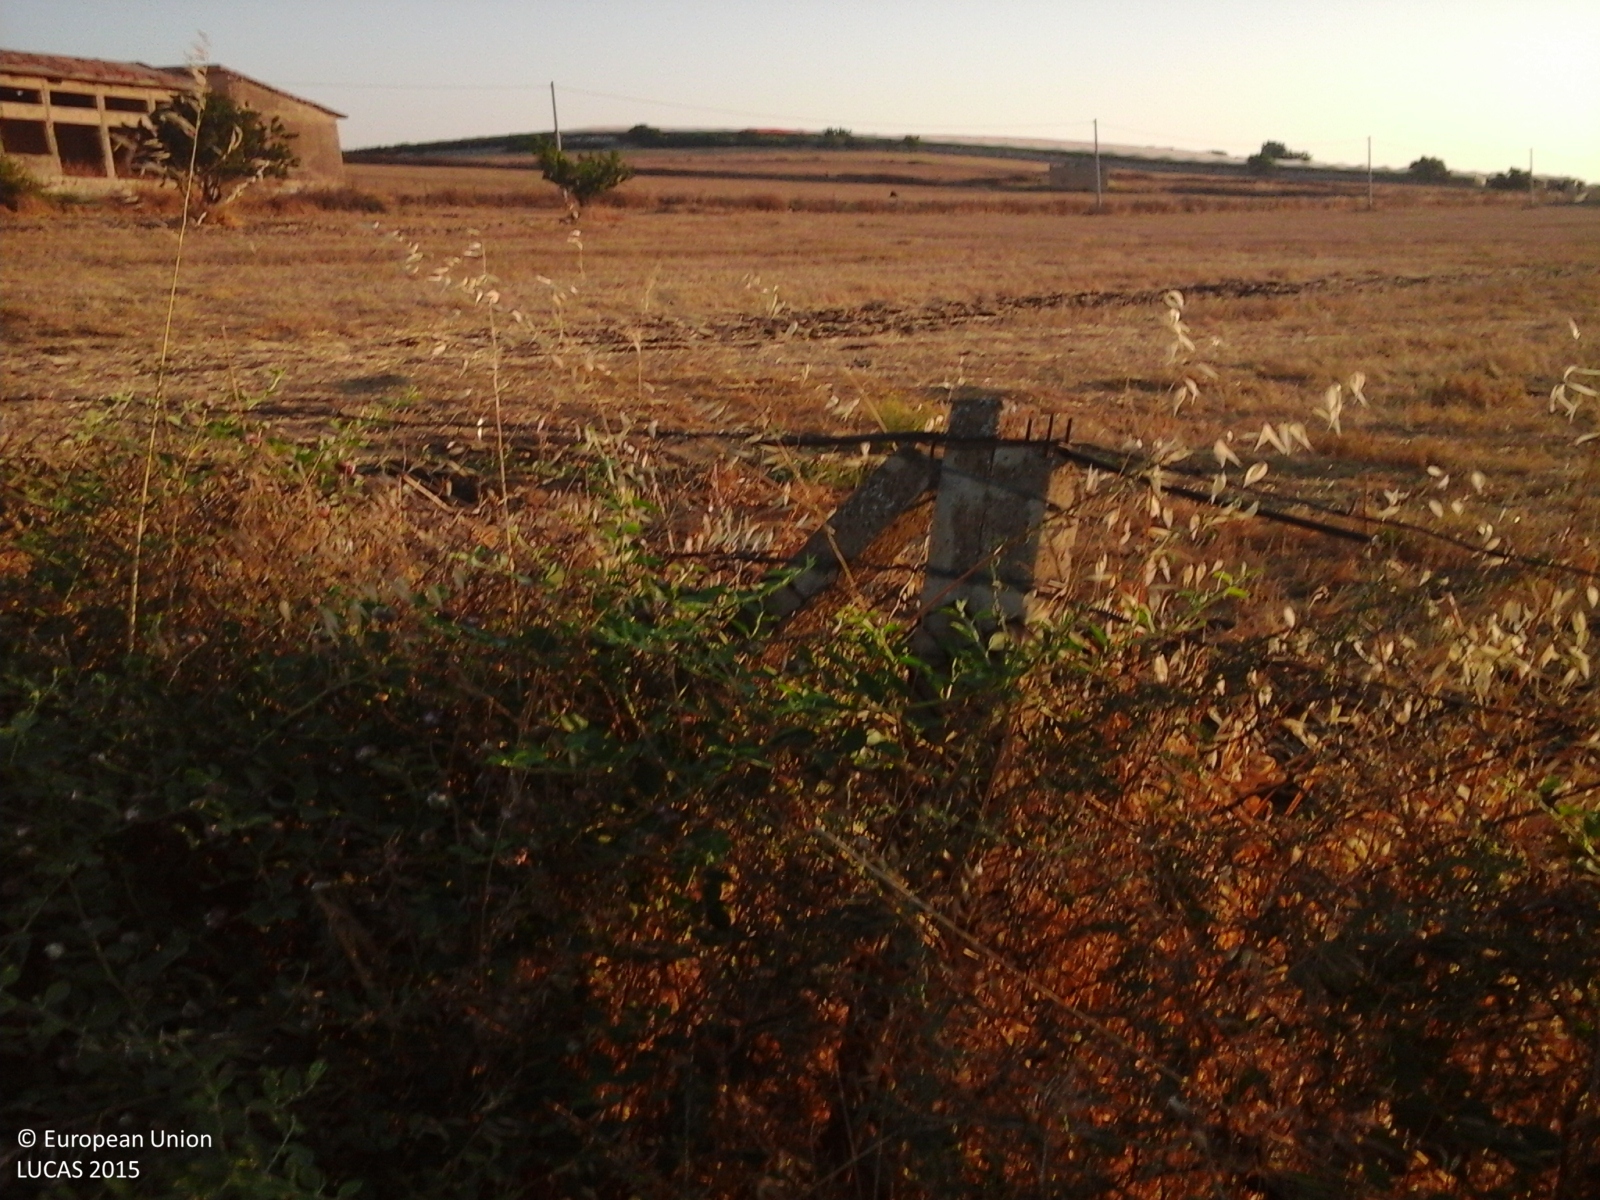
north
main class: Cropland
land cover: Durum wheat
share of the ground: > 75 %
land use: Agriculture (excluding fallow land and kitchen gardens)
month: July
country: IT
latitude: 37.1893
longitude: 14.0351
